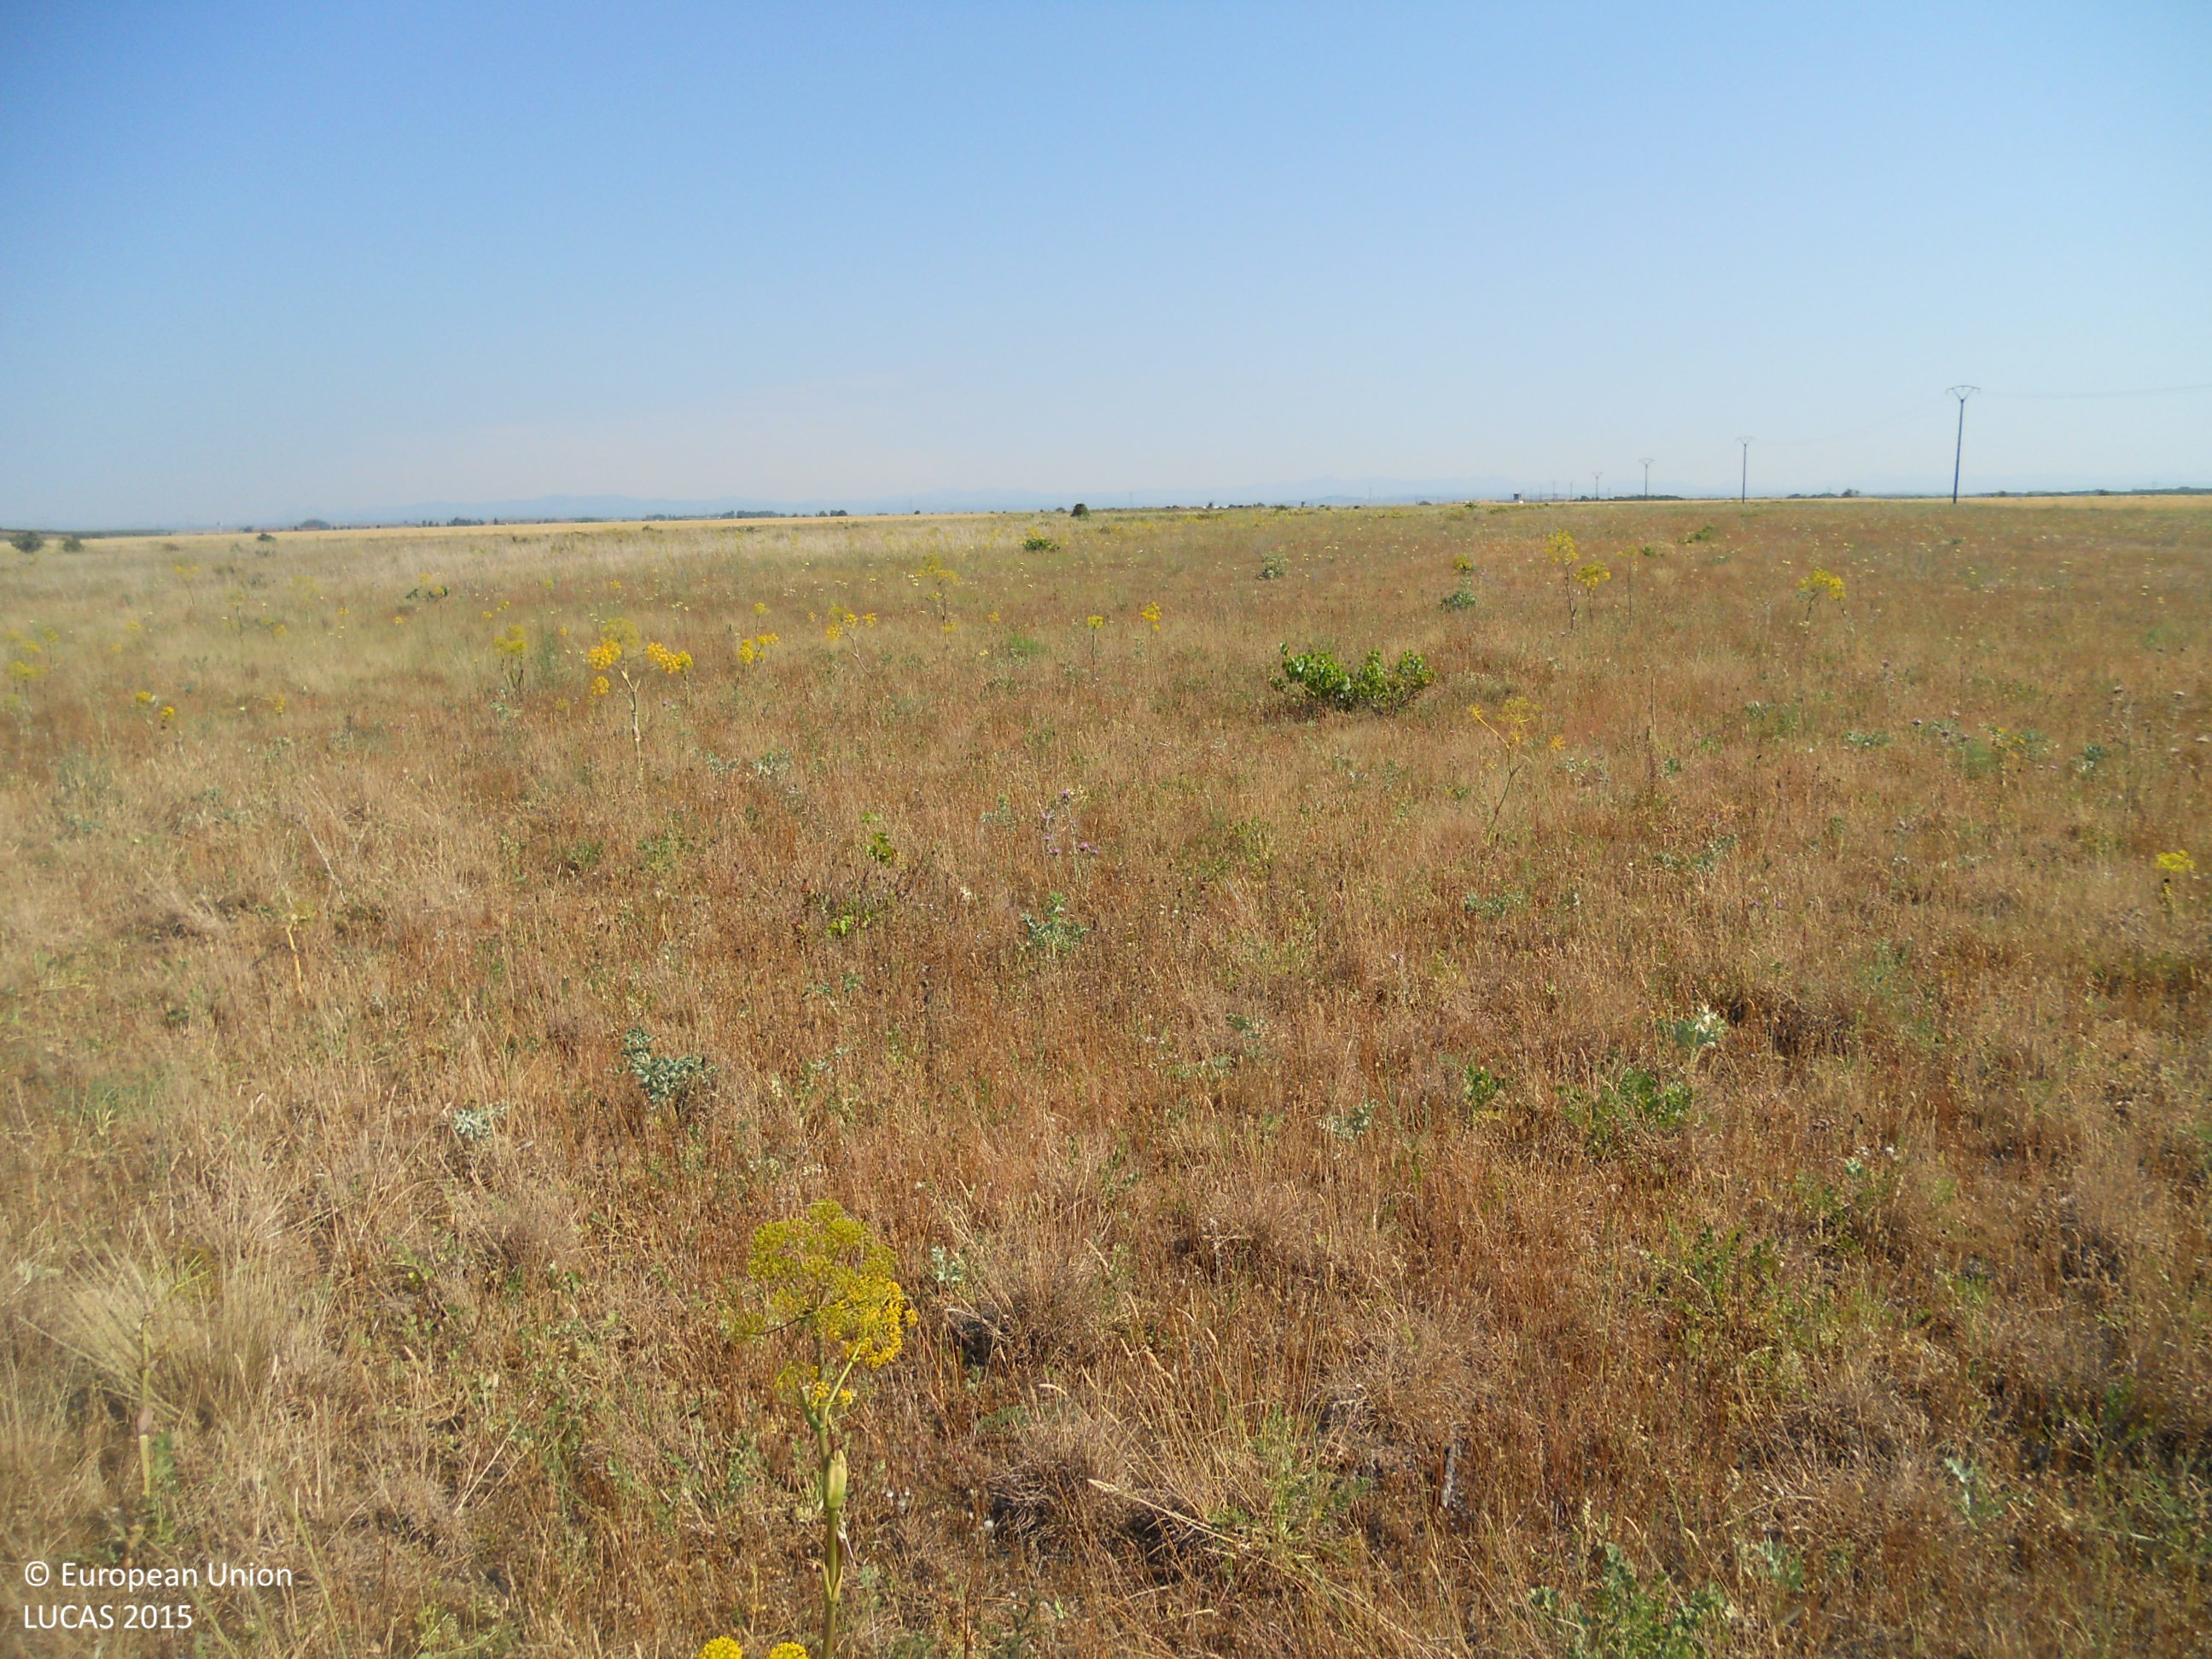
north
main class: Grassland
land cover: Grassland without tree/shrub cover
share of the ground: > 75 %
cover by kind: herbaceous plants 95 %, shrubs 5 %
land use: Semi-natural and natural areas not in use
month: June
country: ES
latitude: 42.4152
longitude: -5.5644
